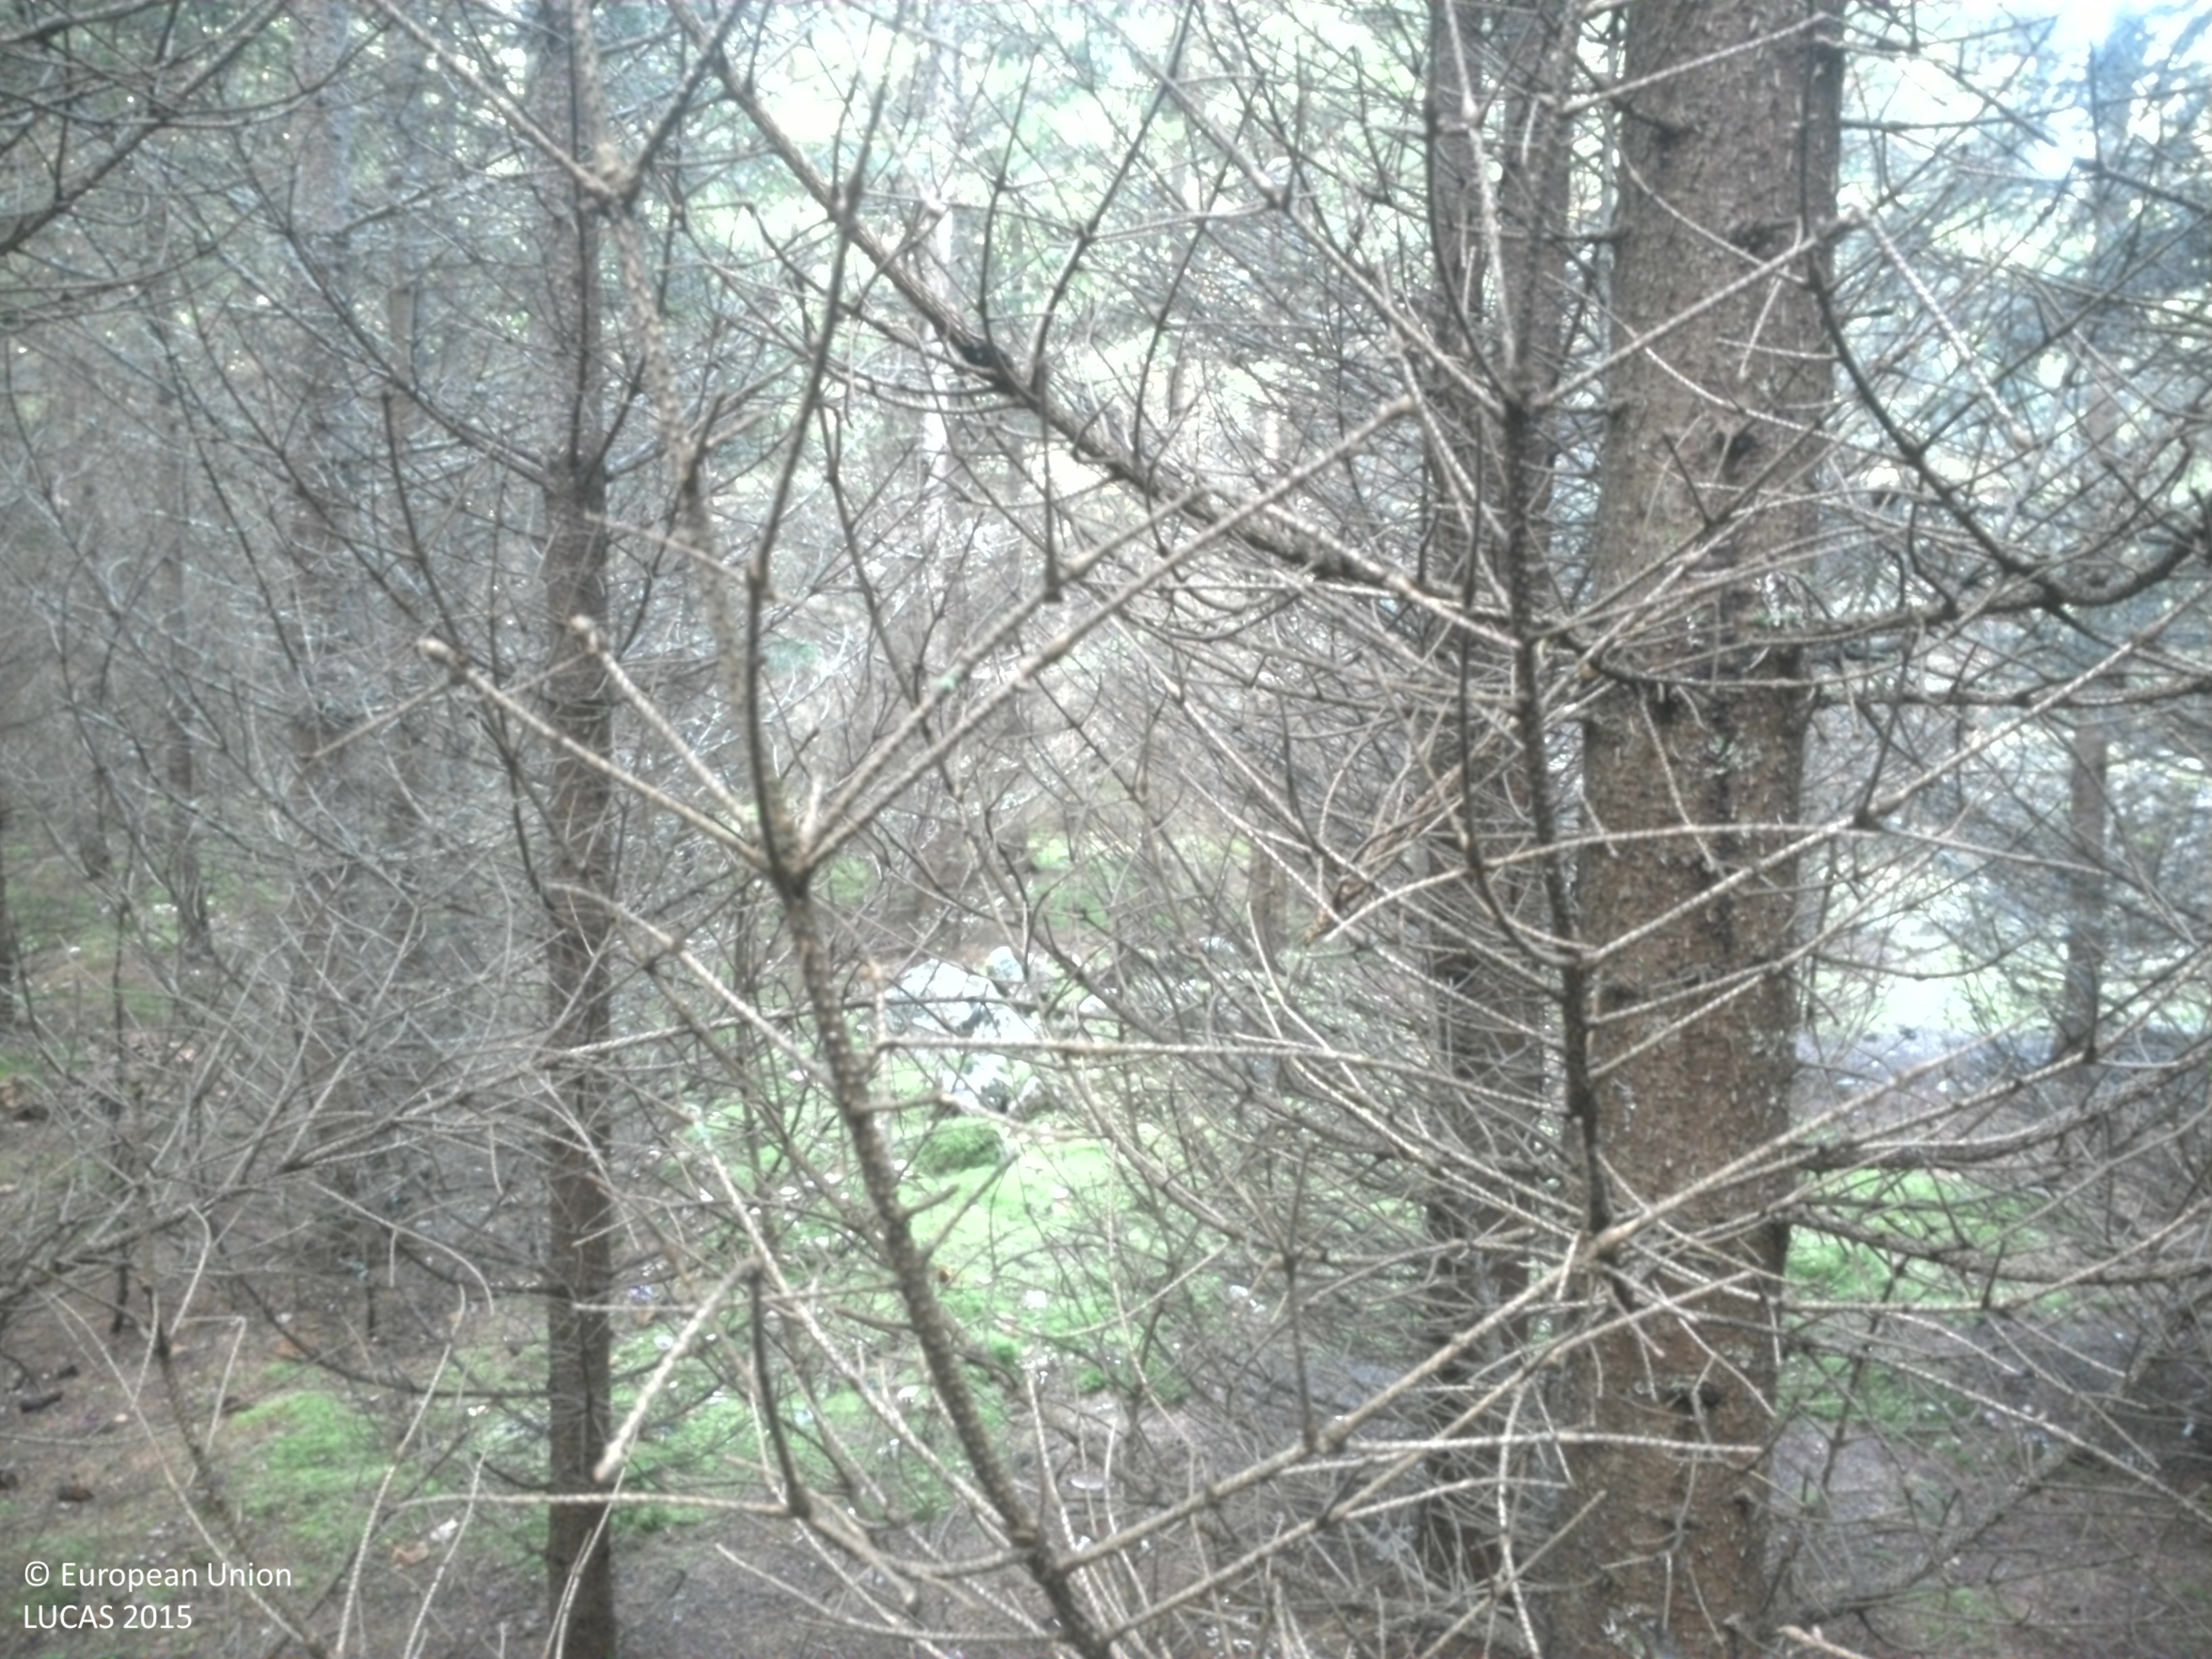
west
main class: Woodland
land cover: Spruce dominated coniferous woodland
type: boreal forest
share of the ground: > 75 %
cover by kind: coniferous forest trees 85 %, lichens and mosses 15 %
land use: Forestry
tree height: > 5 m
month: September
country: SE
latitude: 59.4800
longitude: 15.4462
